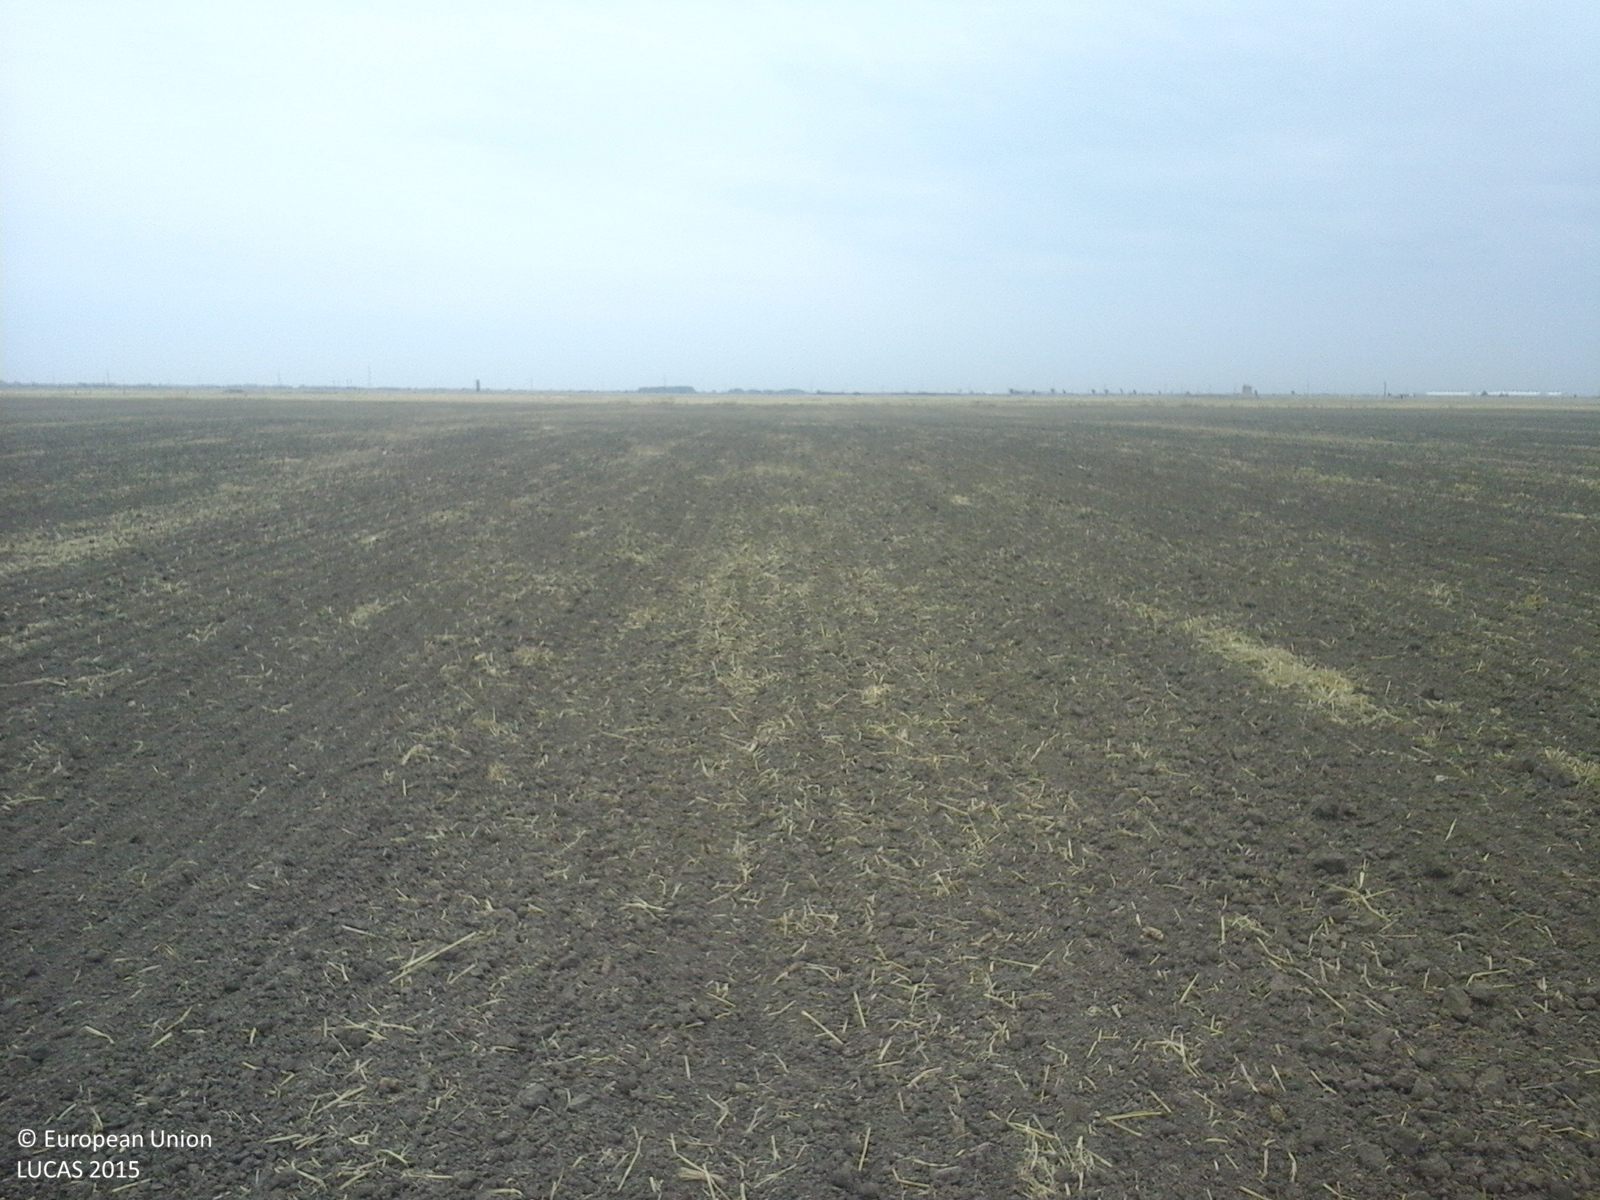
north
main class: Cropland
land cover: Common wheat
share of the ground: < 10 %
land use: Agriculture (excluding fallow land and kitchen gardens)
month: September
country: RO
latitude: 47.6683
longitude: 22.5372
